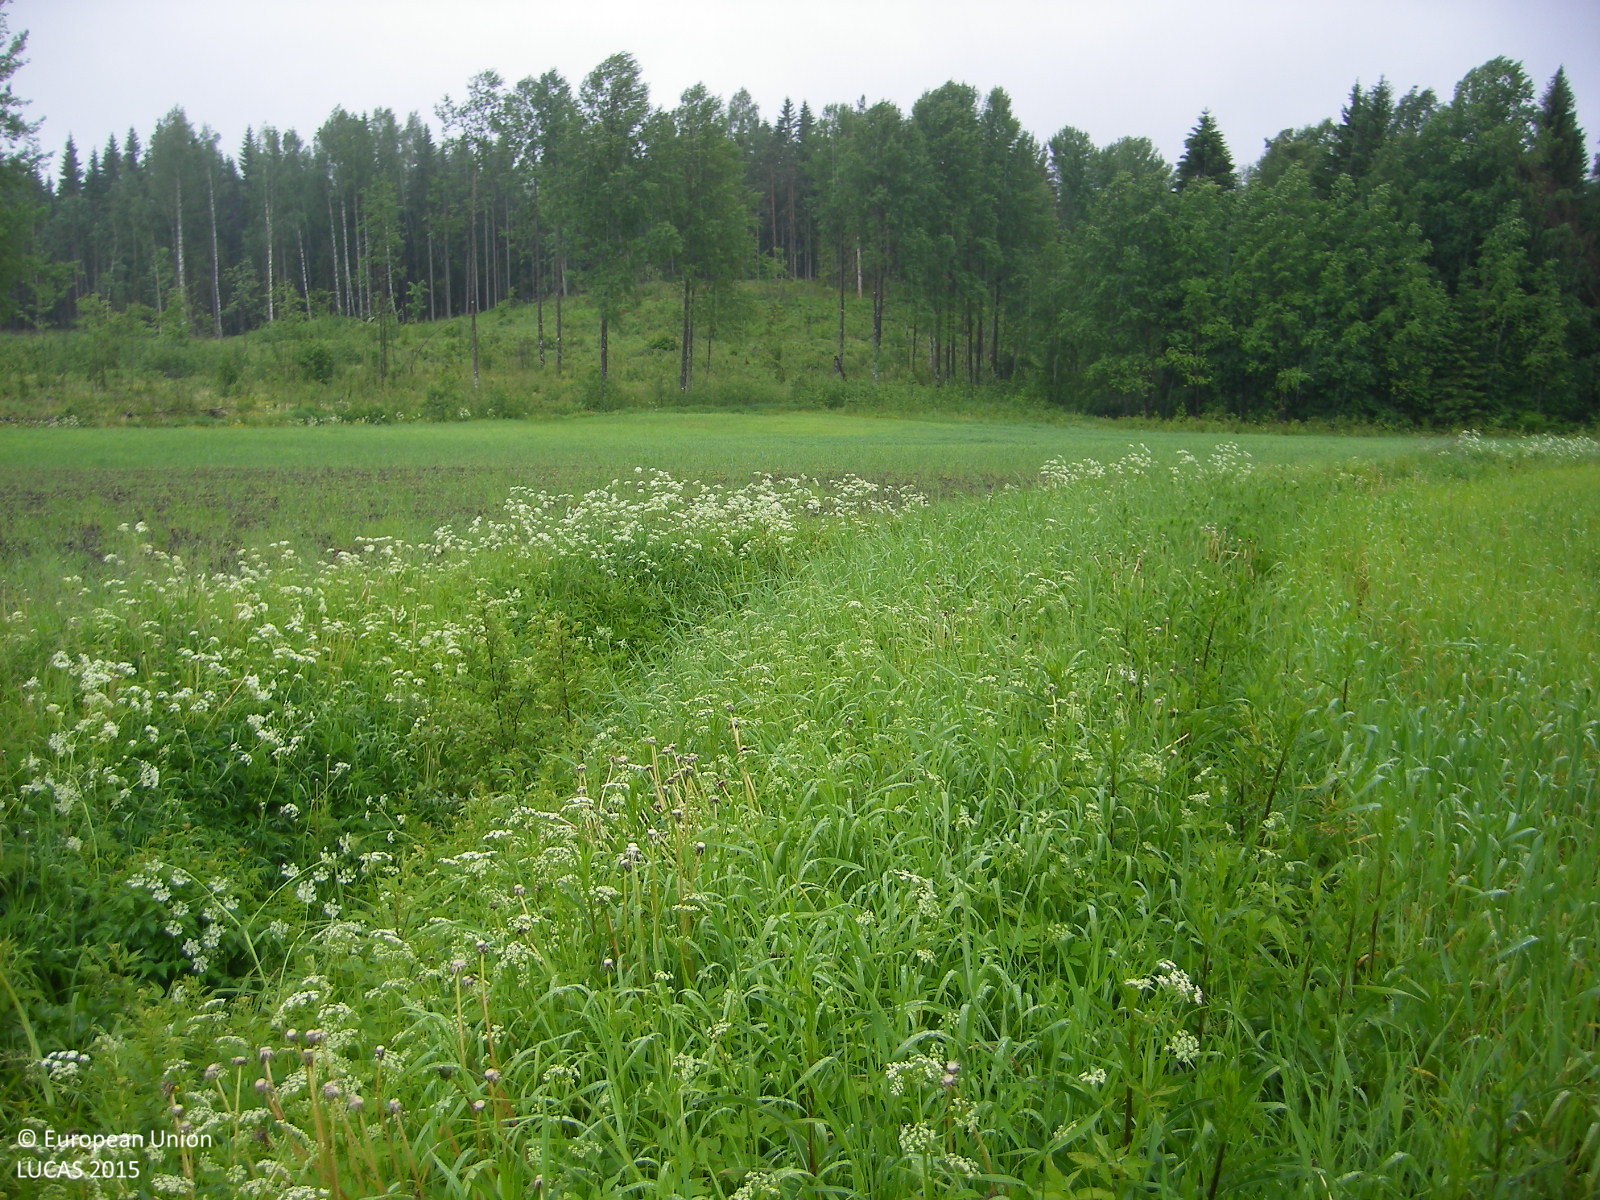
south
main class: Cropland
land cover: Common wheat
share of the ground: > 75 %
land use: Agriculture (excluding fallow land and kitchen gardens)
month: June
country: FI
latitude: 60.1287
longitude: 24.0865
